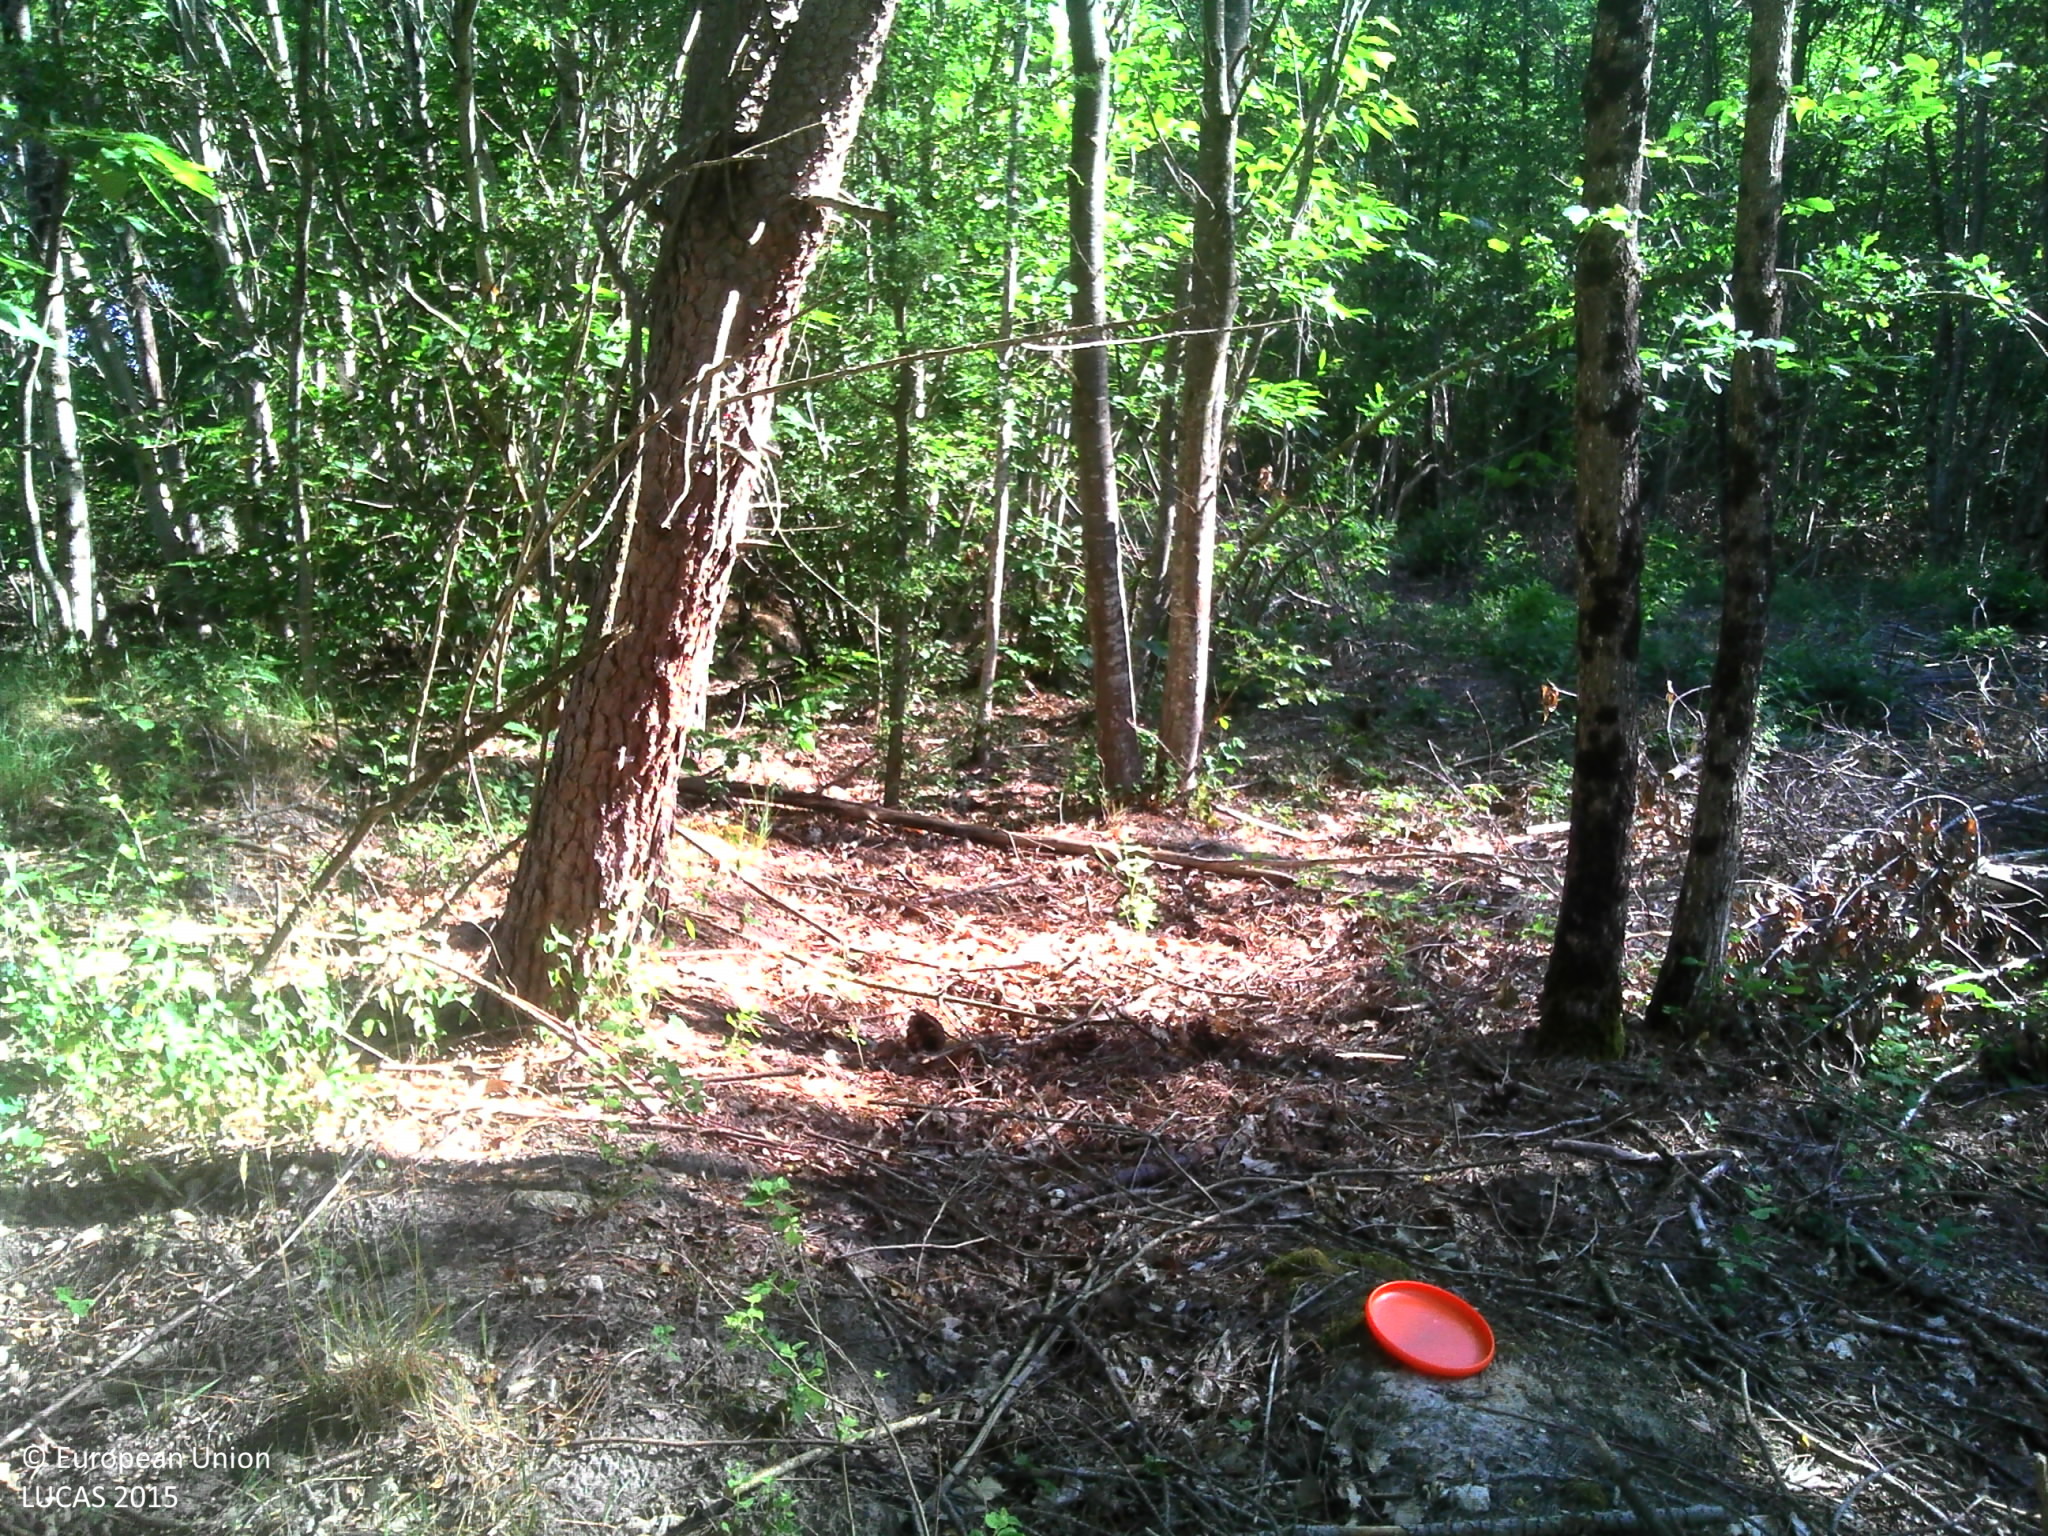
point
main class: Woodland
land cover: Broadleaved woodland
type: mesophytic deciduous forest
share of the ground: > 75 %
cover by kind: broadleaved forest trees 75 %, shrubs 10 %, coniferous forest trees 5 %, herbaceous plants 5 %, lichens and mosses 5 %
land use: Forestry
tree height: > 5 m
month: June
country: FR
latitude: 47.4001
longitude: 0.3447
